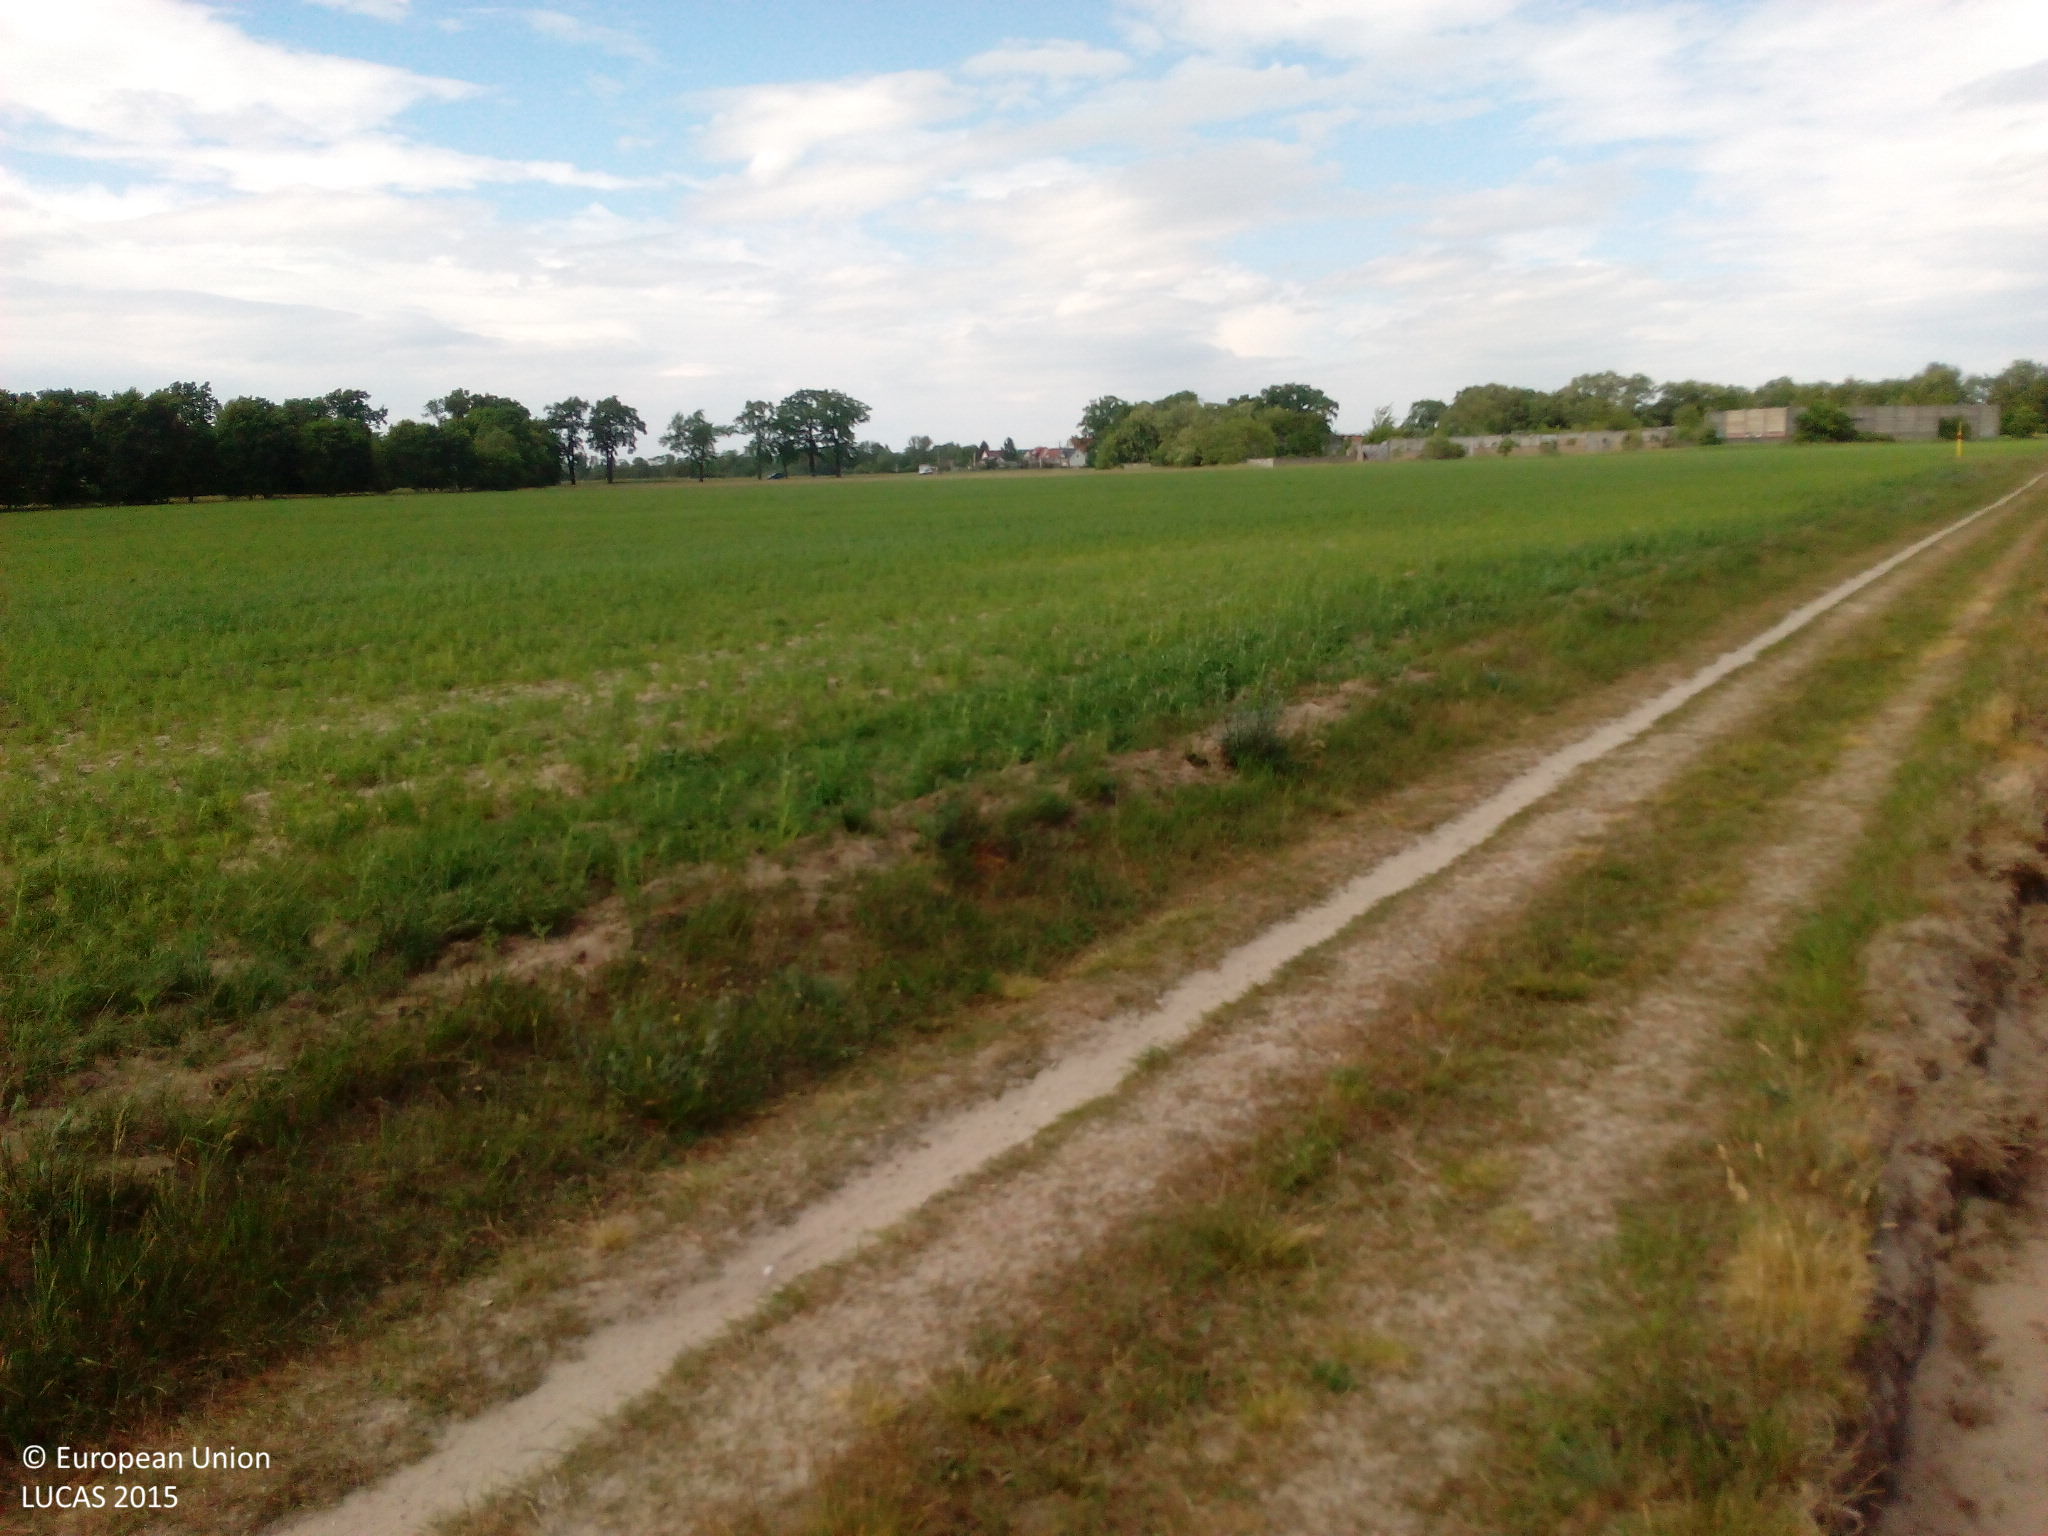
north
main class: Cropland
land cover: Rye
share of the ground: > 75 %
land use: Agriculture (excluding fallow land and kitchen gardens)
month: June
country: DE
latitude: 52.4029
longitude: 12.6013
